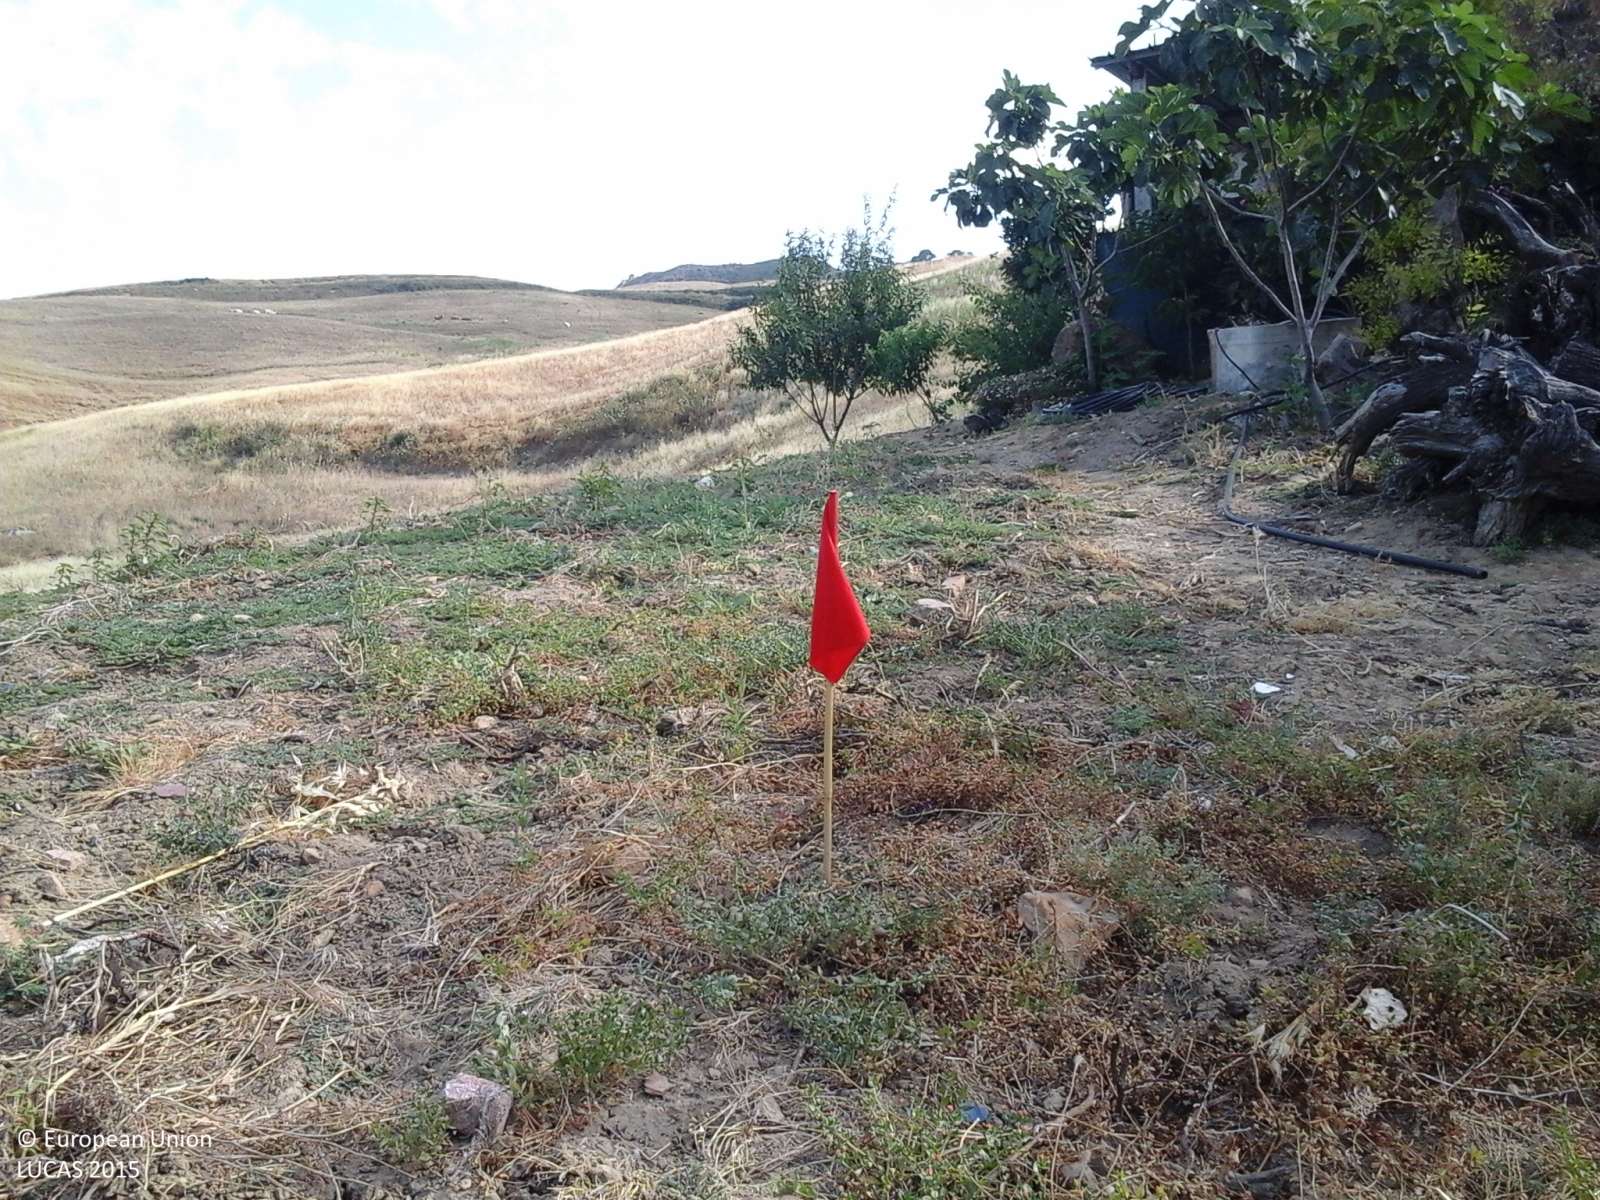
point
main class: Cropland
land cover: Other fresh vegetables
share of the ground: 10 - 25 %
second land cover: Spontaneously vegetated surfaces
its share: 10 - 25 %
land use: Kitchen garden
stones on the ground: 10 - 25 %
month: June
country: IT
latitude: 37.8412
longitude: 13.6441
